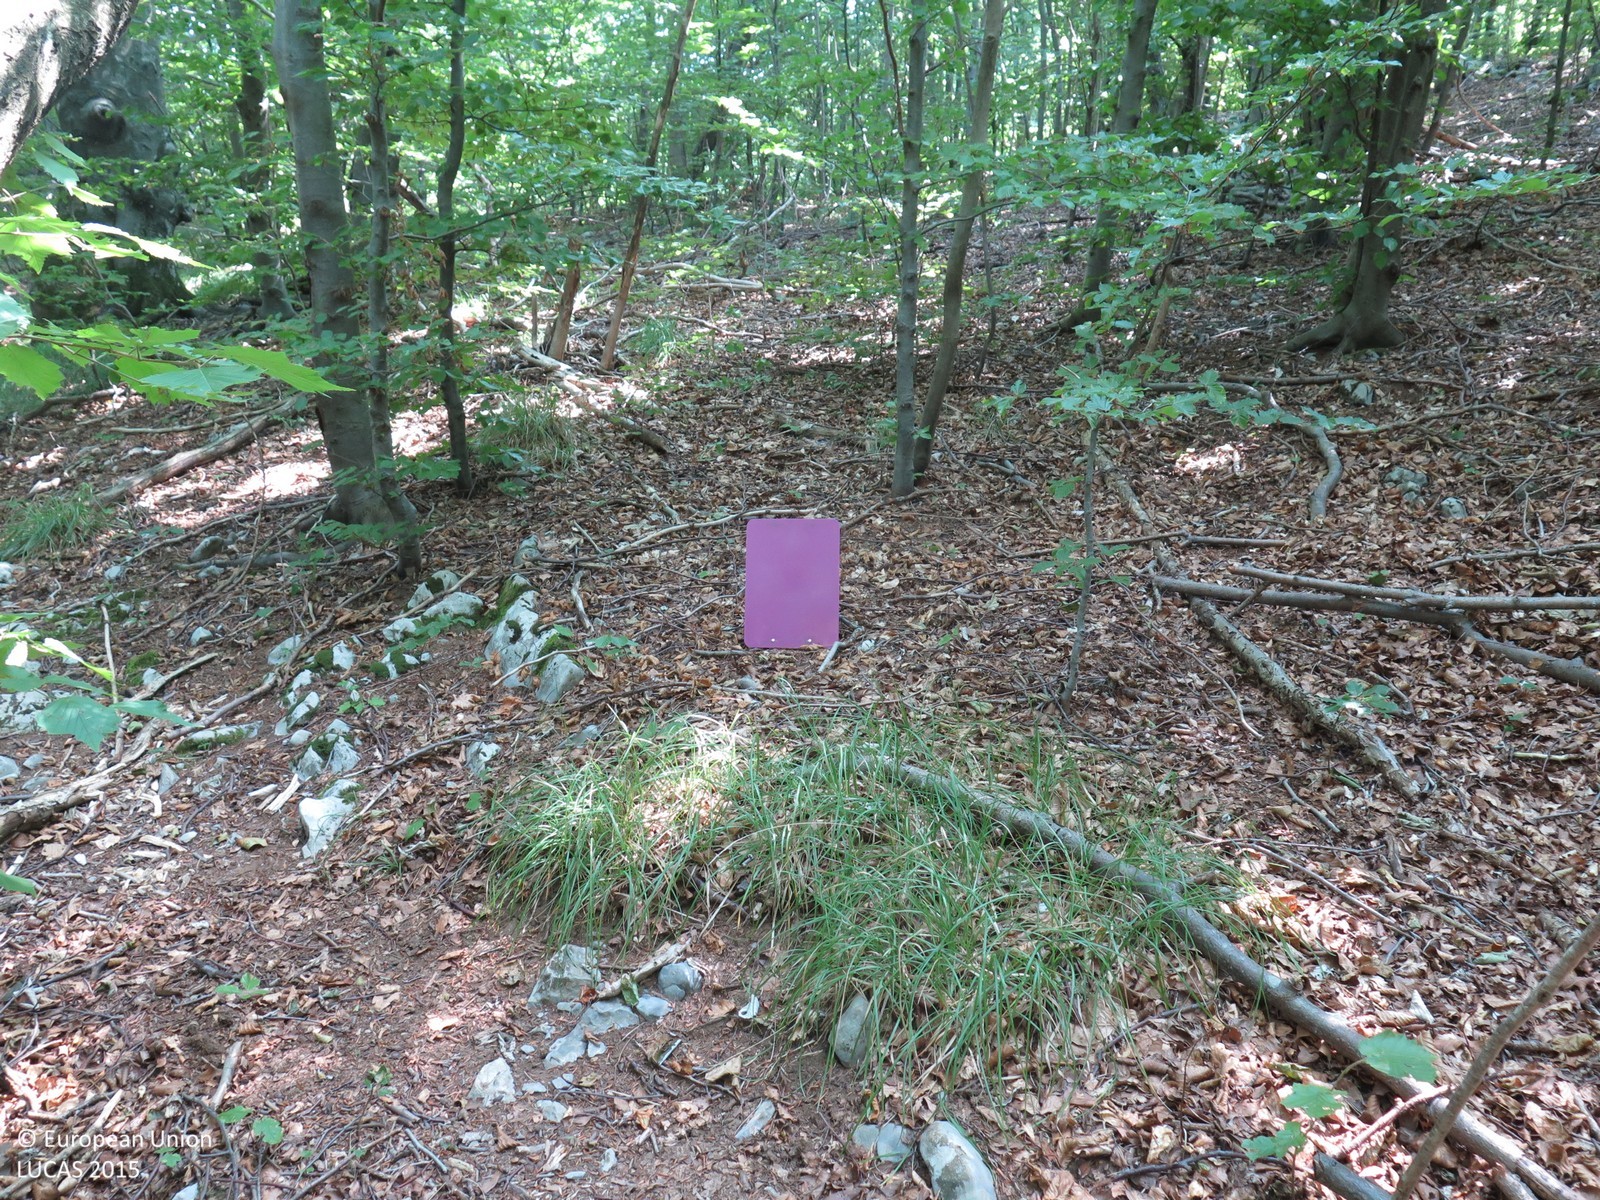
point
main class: Woodland
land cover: Broadleaved woodland
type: beech forest
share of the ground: > 75 %
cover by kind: broadleaved forest trees 90 %, herbaceous plants 5 %, unconsolidated bare surface 5 %
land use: Forestry
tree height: > 5 m
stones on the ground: 10 - 25 %
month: August
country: HR
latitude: 45.3679
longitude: 14.6043
